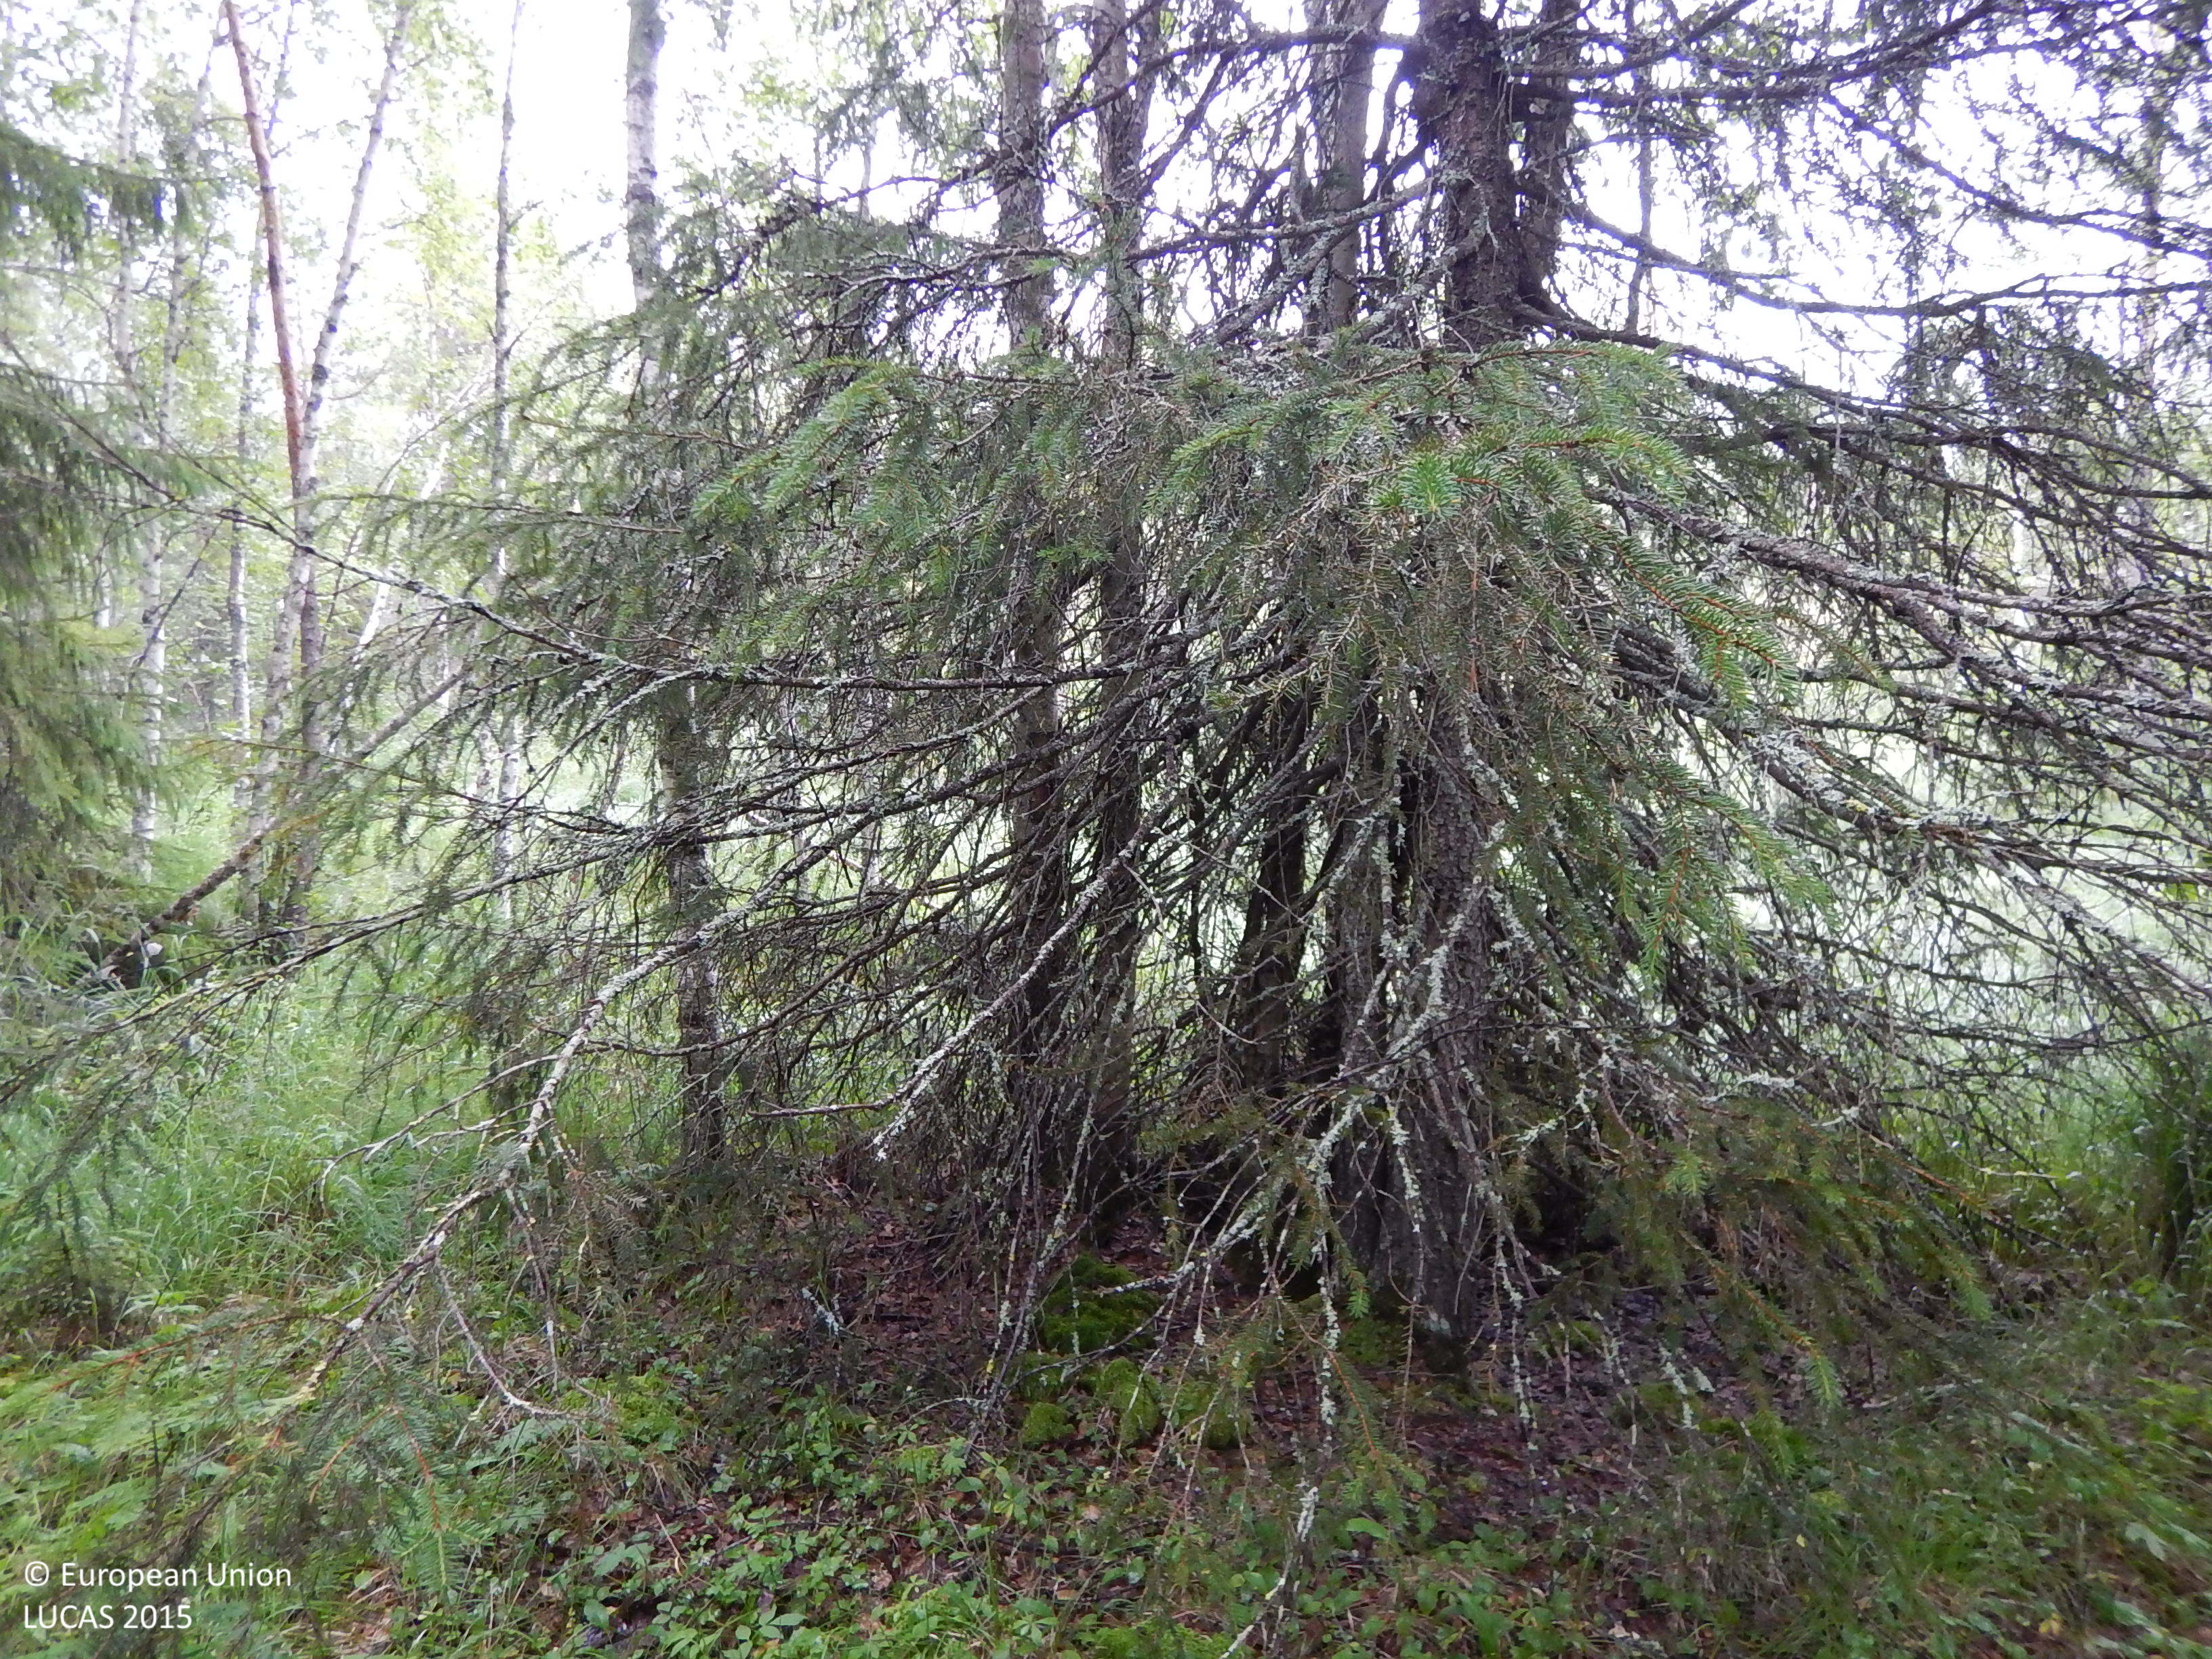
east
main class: Woodland
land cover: Other mixed woodland
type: boreal forest
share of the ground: 50 - 75 %
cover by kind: broadleaved forest trees 40 %, herbaceous plants 20 %, coniferous forest trees 15 %, lichens and mosses 15 %, shrubs 10 %
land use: Forestry
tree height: > 5 m
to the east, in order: Other mixed woodland; Broadleaved woodland; Inland marshes; Pine dominated coniferous woodland; Pine dominated mixed woodland
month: July
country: SE
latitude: 64.9853
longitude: 20.4210
